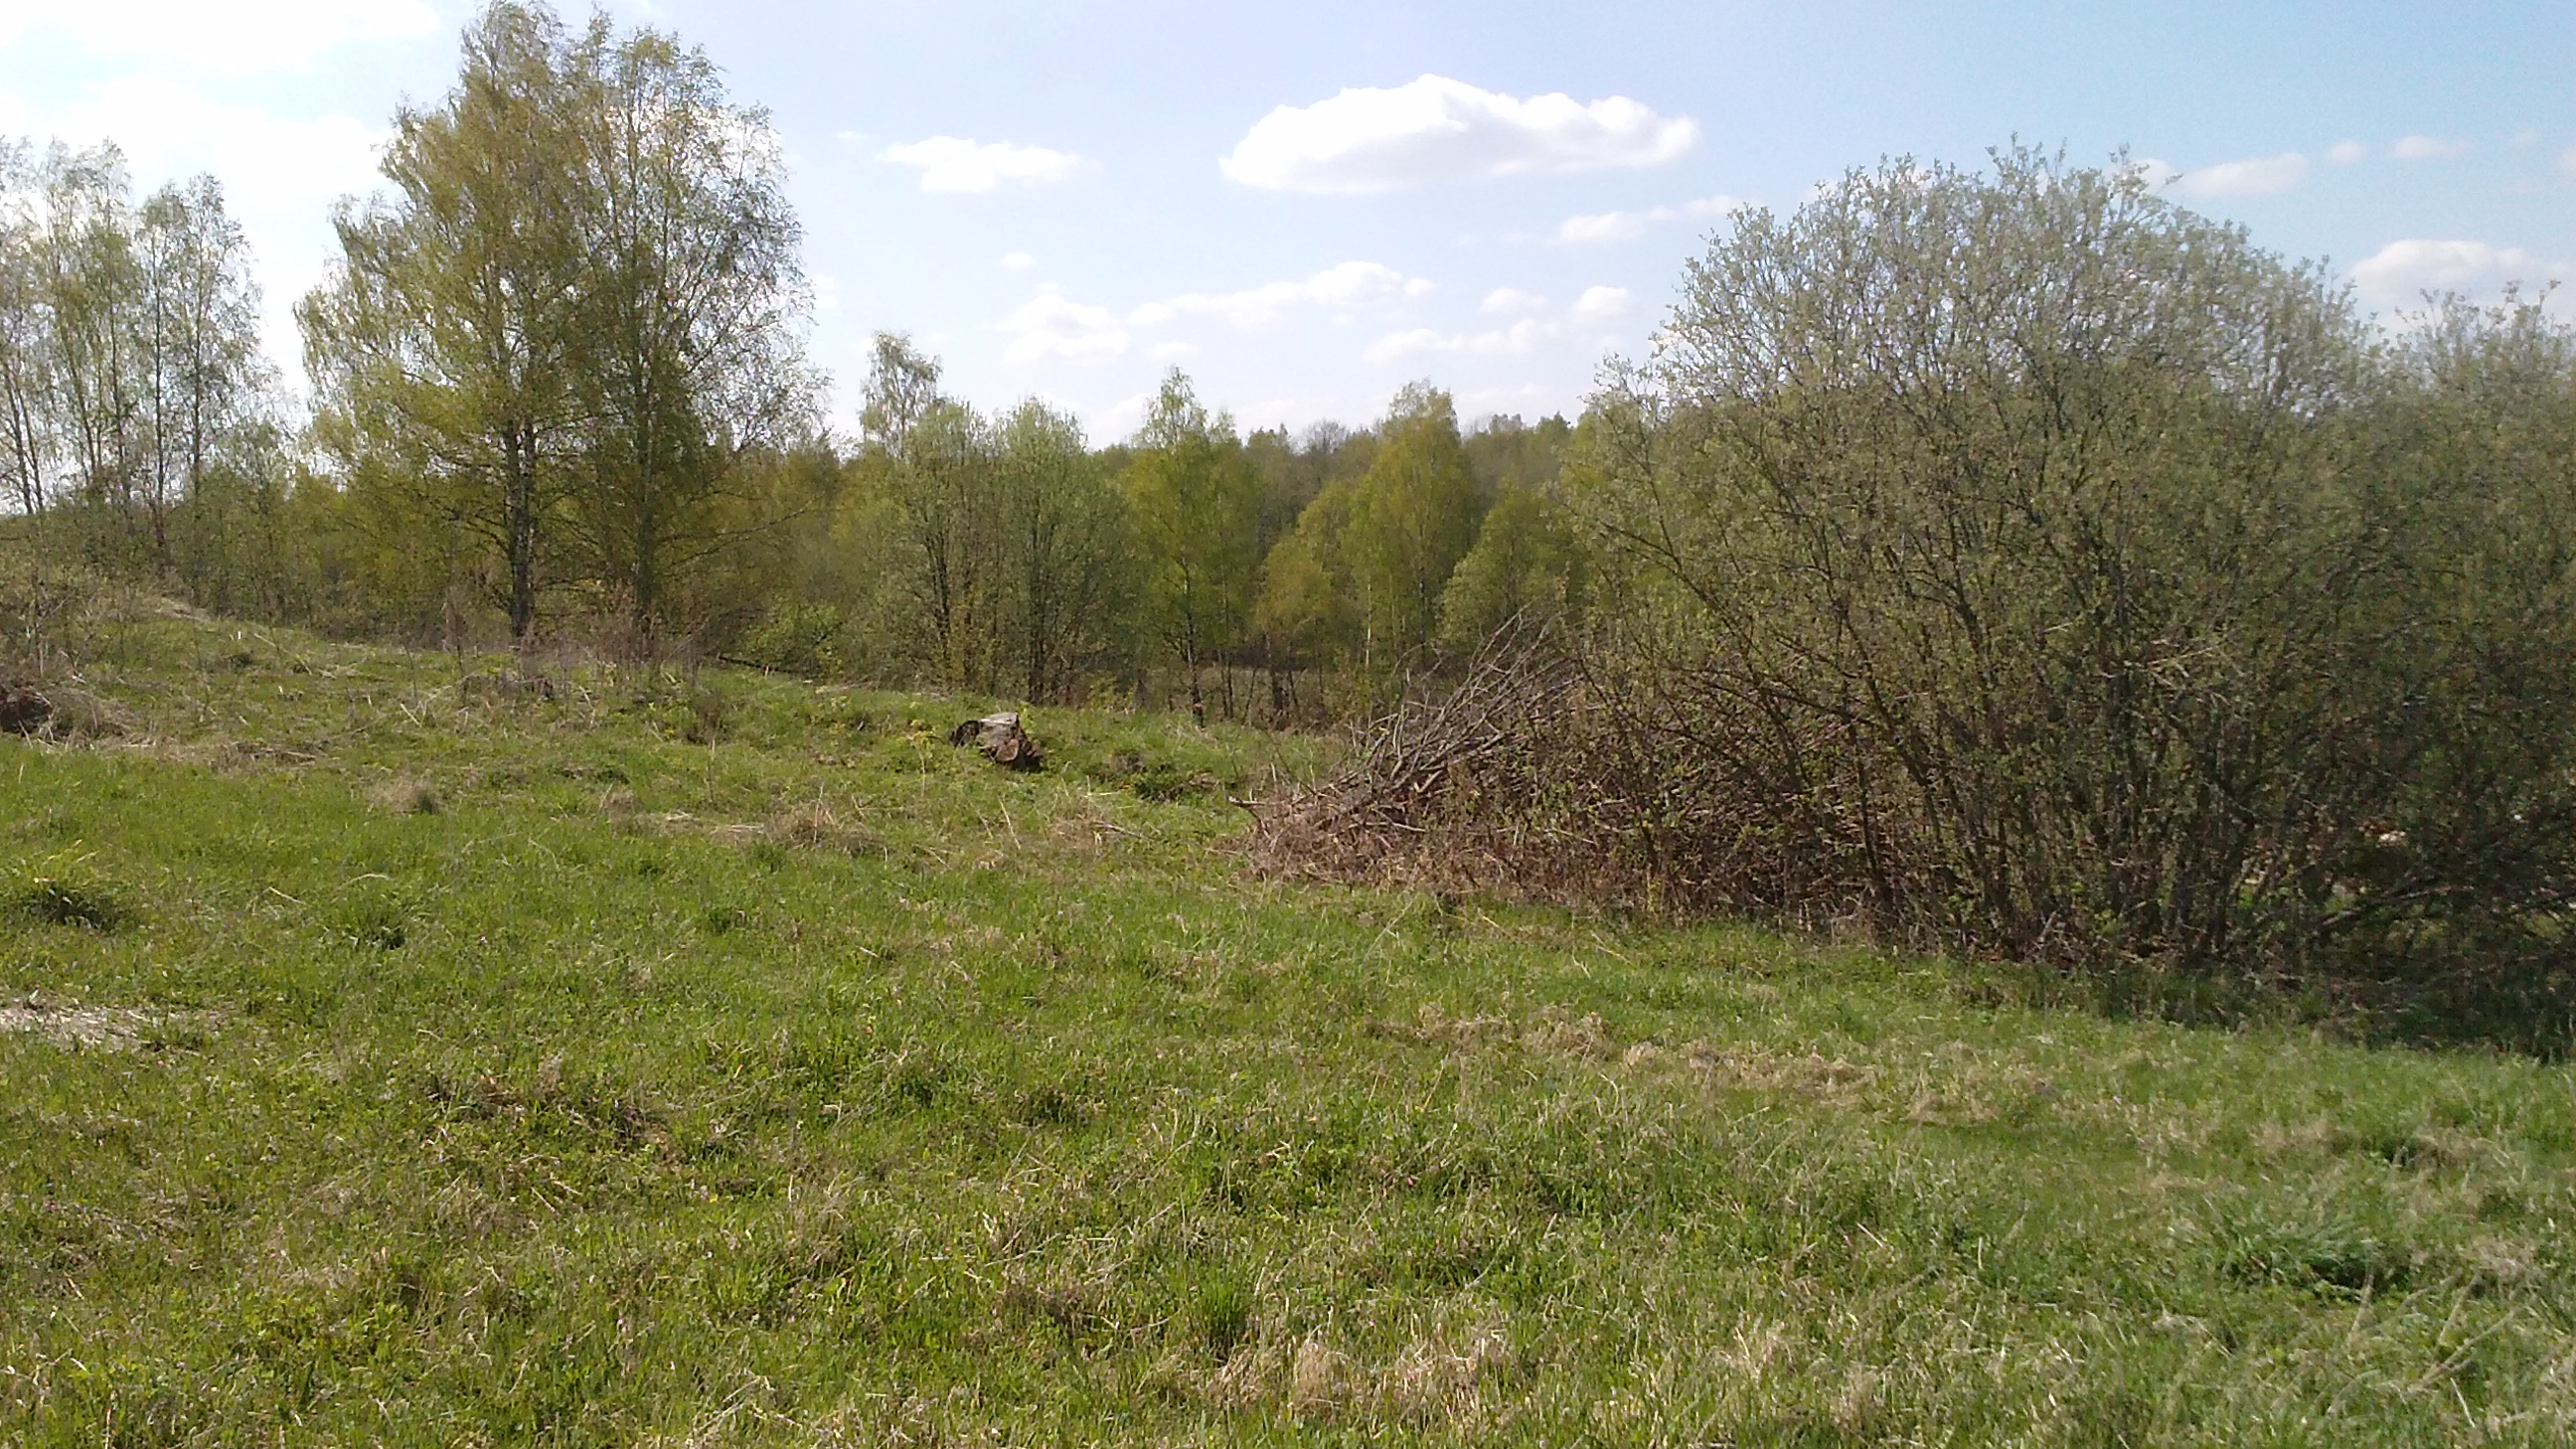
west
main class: Grassland
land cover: Grassland without tree/shrub cover
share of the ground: > 75 %
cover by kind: herbaceous plants 100 %
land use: Agriculture (excluding fallow land and kitchen gardens)
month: May
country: LV
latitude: 55.9800
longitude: 27.4070
